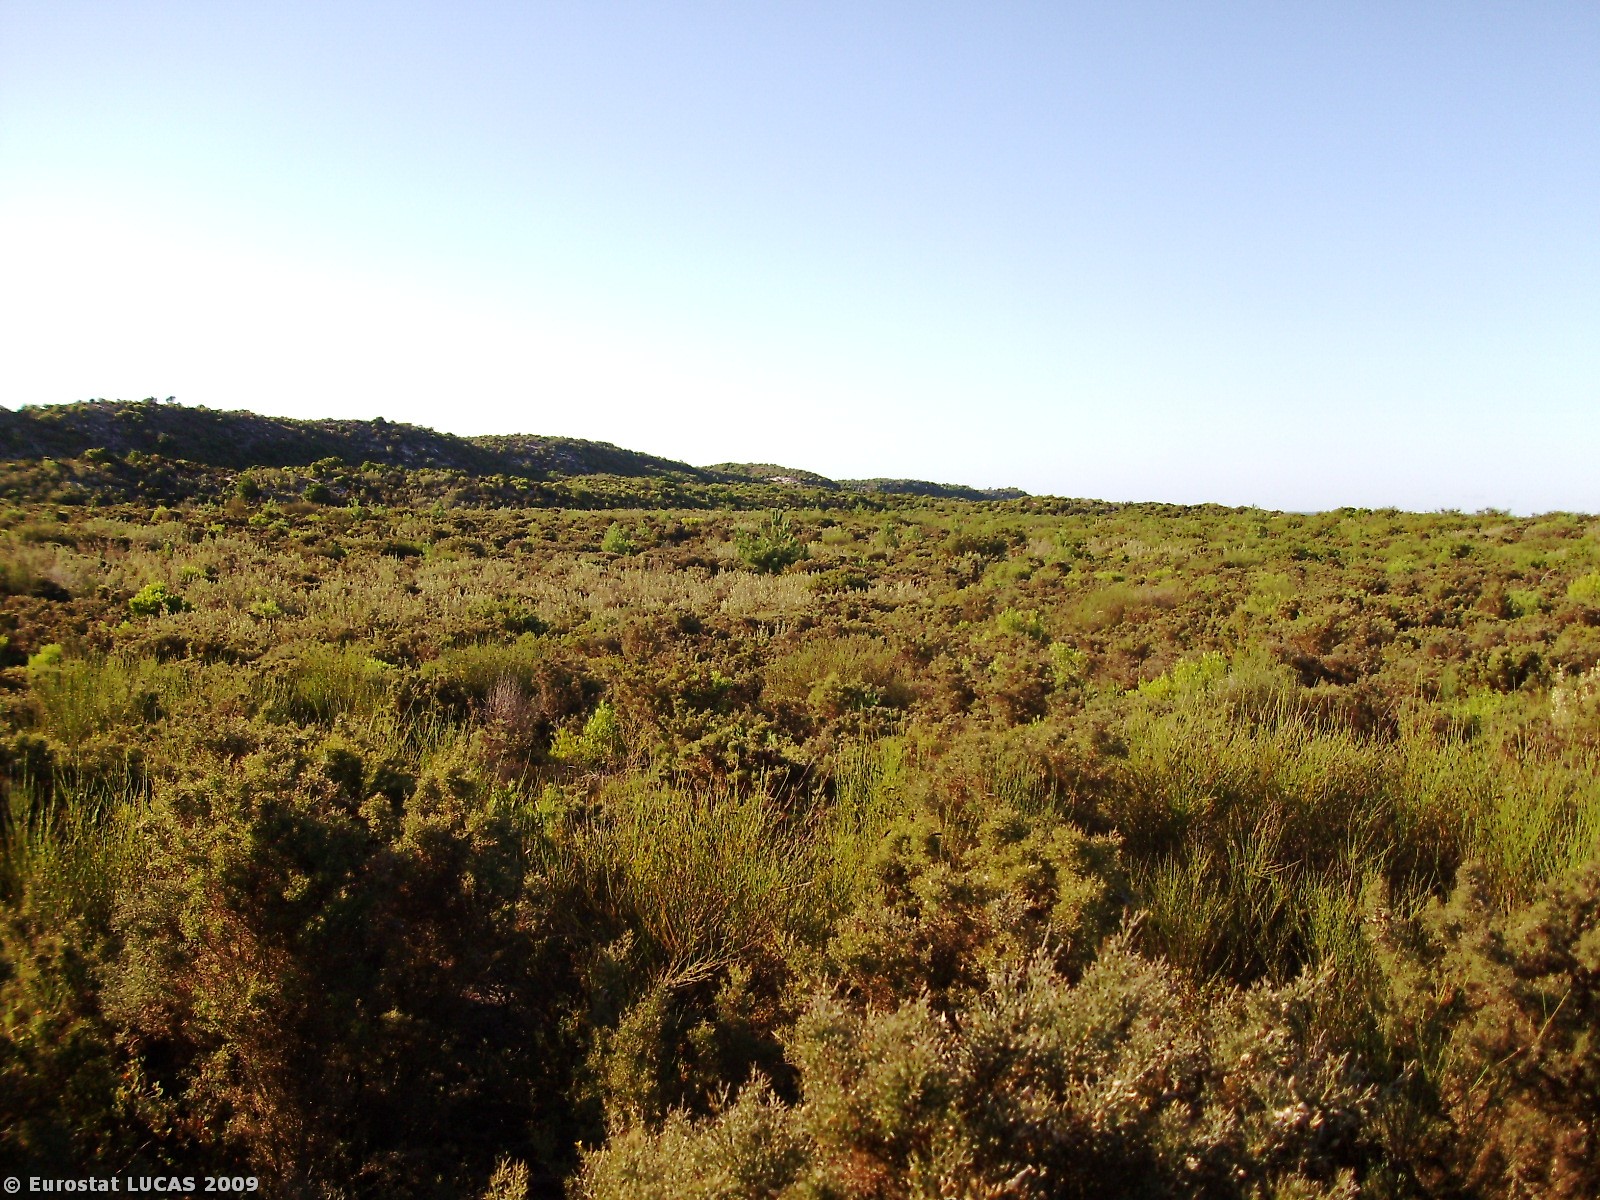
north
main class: Shrubland
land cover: Shrubland without tree cover
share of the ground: > 75 %
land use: Nature reserves
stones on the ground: < 10 %
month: July
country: PT
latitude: 39.8253
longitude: -8.9608
